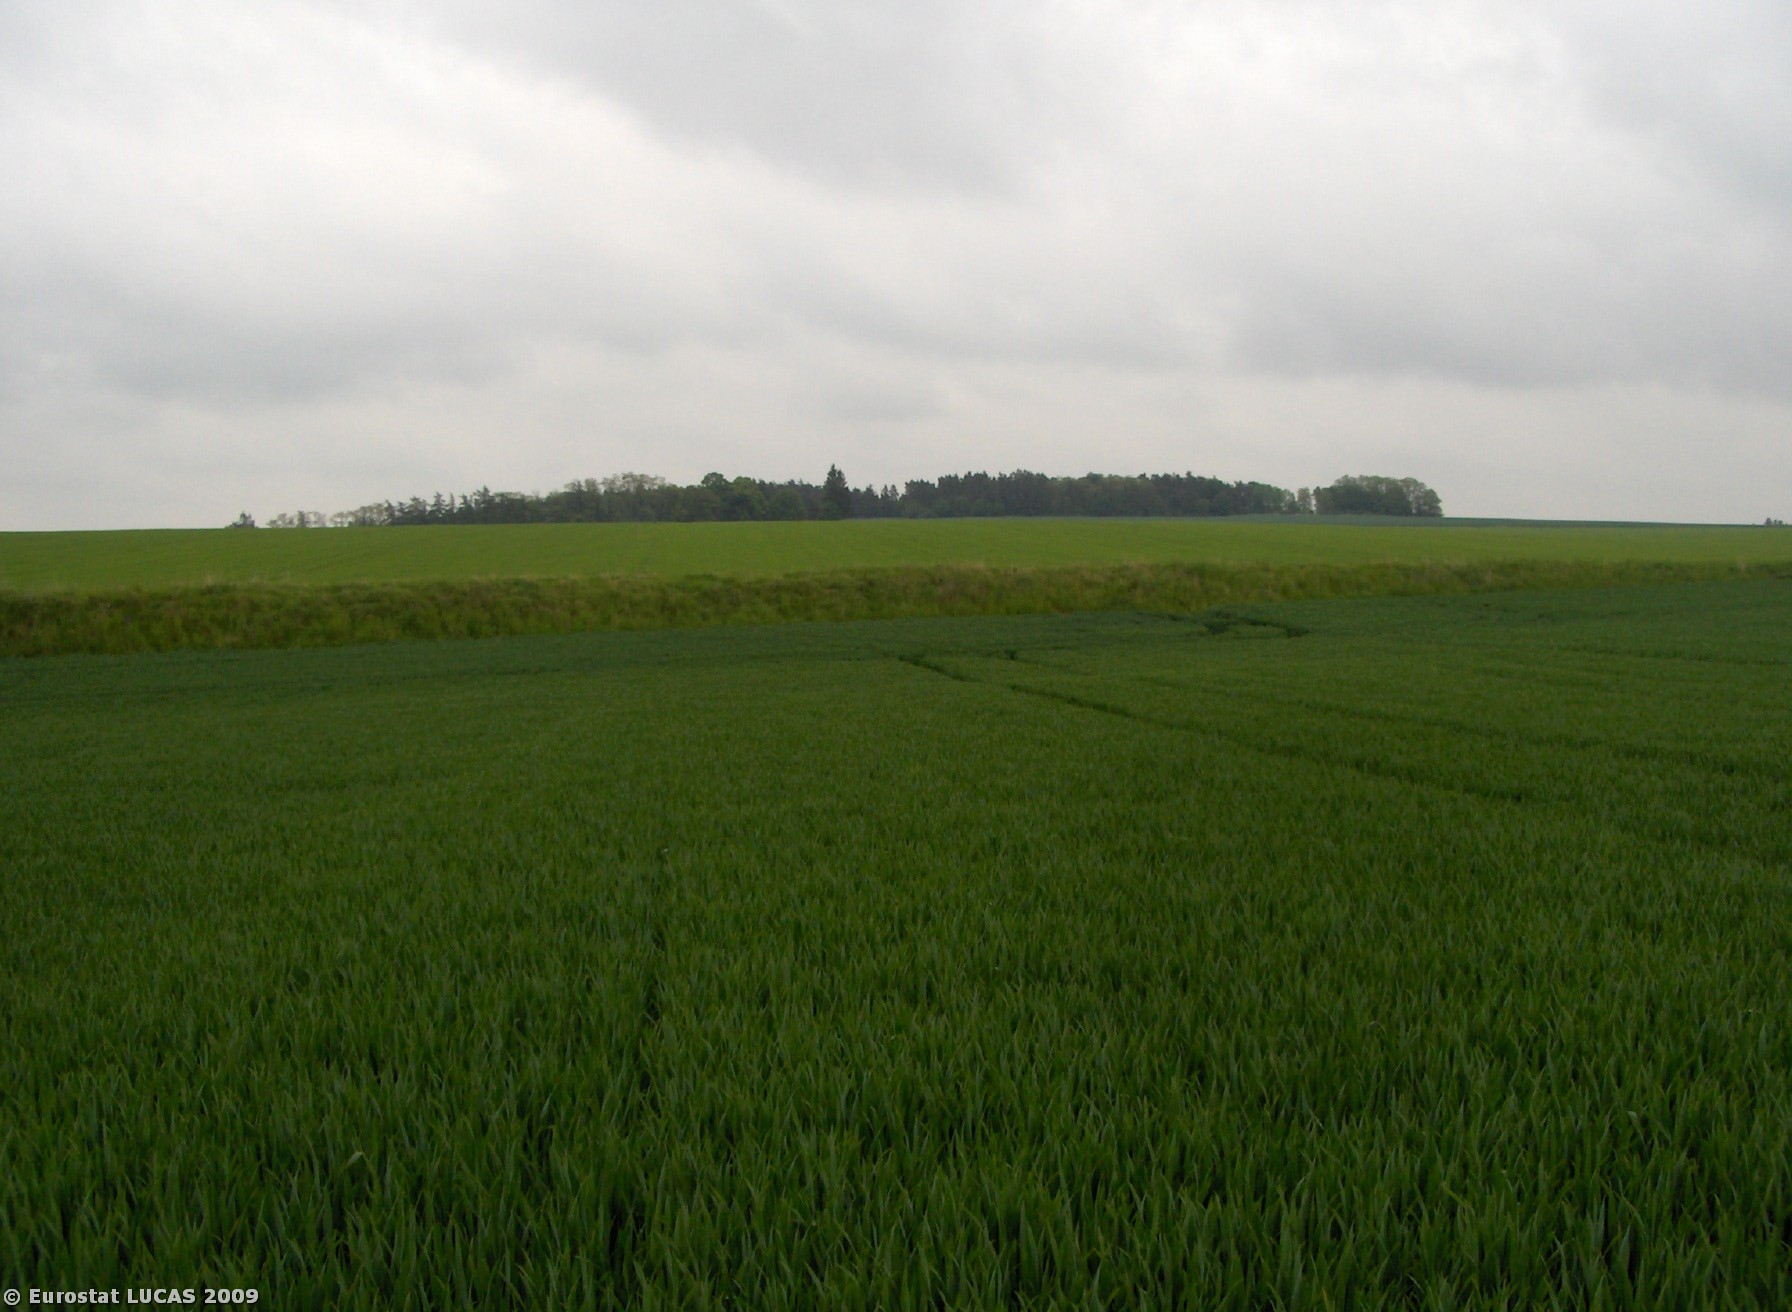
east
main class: Cropland
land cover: Common wheat
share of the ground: > 75 %
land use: Agriculture (excluding fallow land and kitchen gardens)
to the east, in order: Common wheat; Tracks; Grassland without tree/shrub cover; Tracks; Barley
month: May
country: CZ
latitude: 49.3992
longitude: 17.1617
